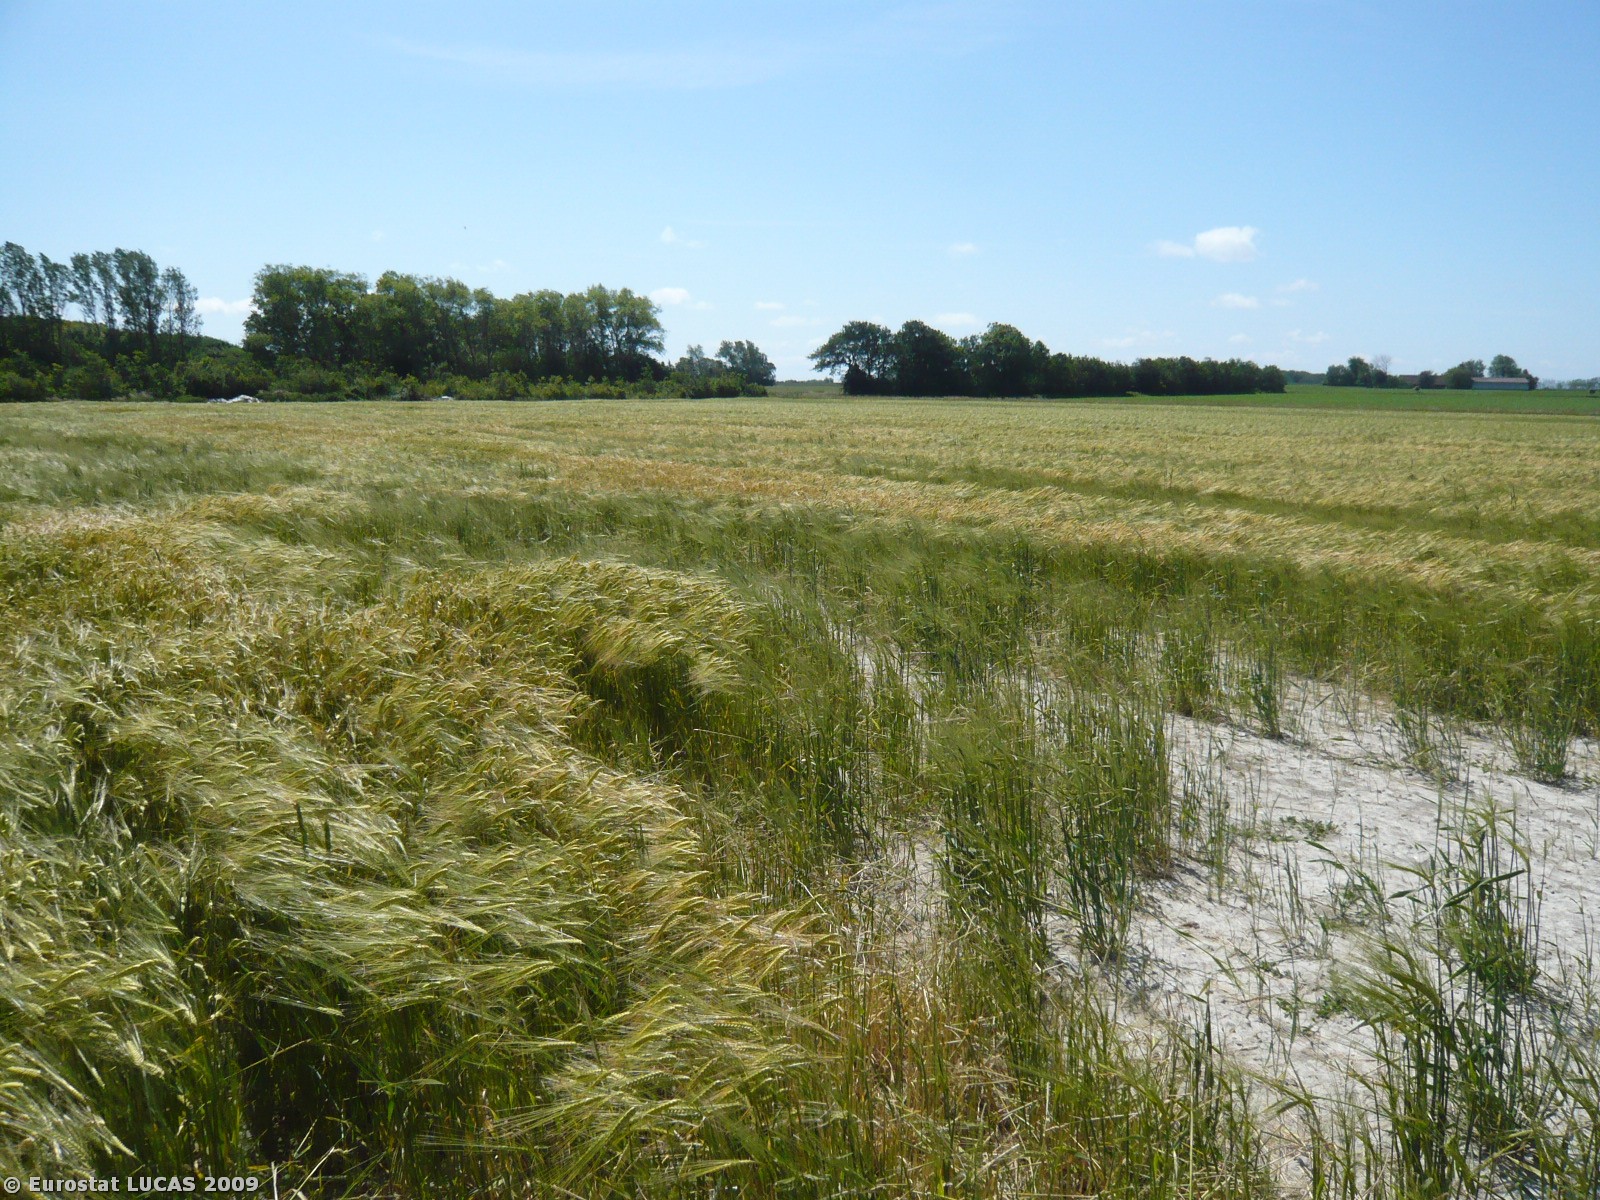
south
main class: Cropland
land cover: Barley
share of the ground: 50 - 75 %
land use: Agriculture (excluding fallow land and kitchen gardens)
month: June
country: DK
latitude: 54.7069
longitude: 11.3183
